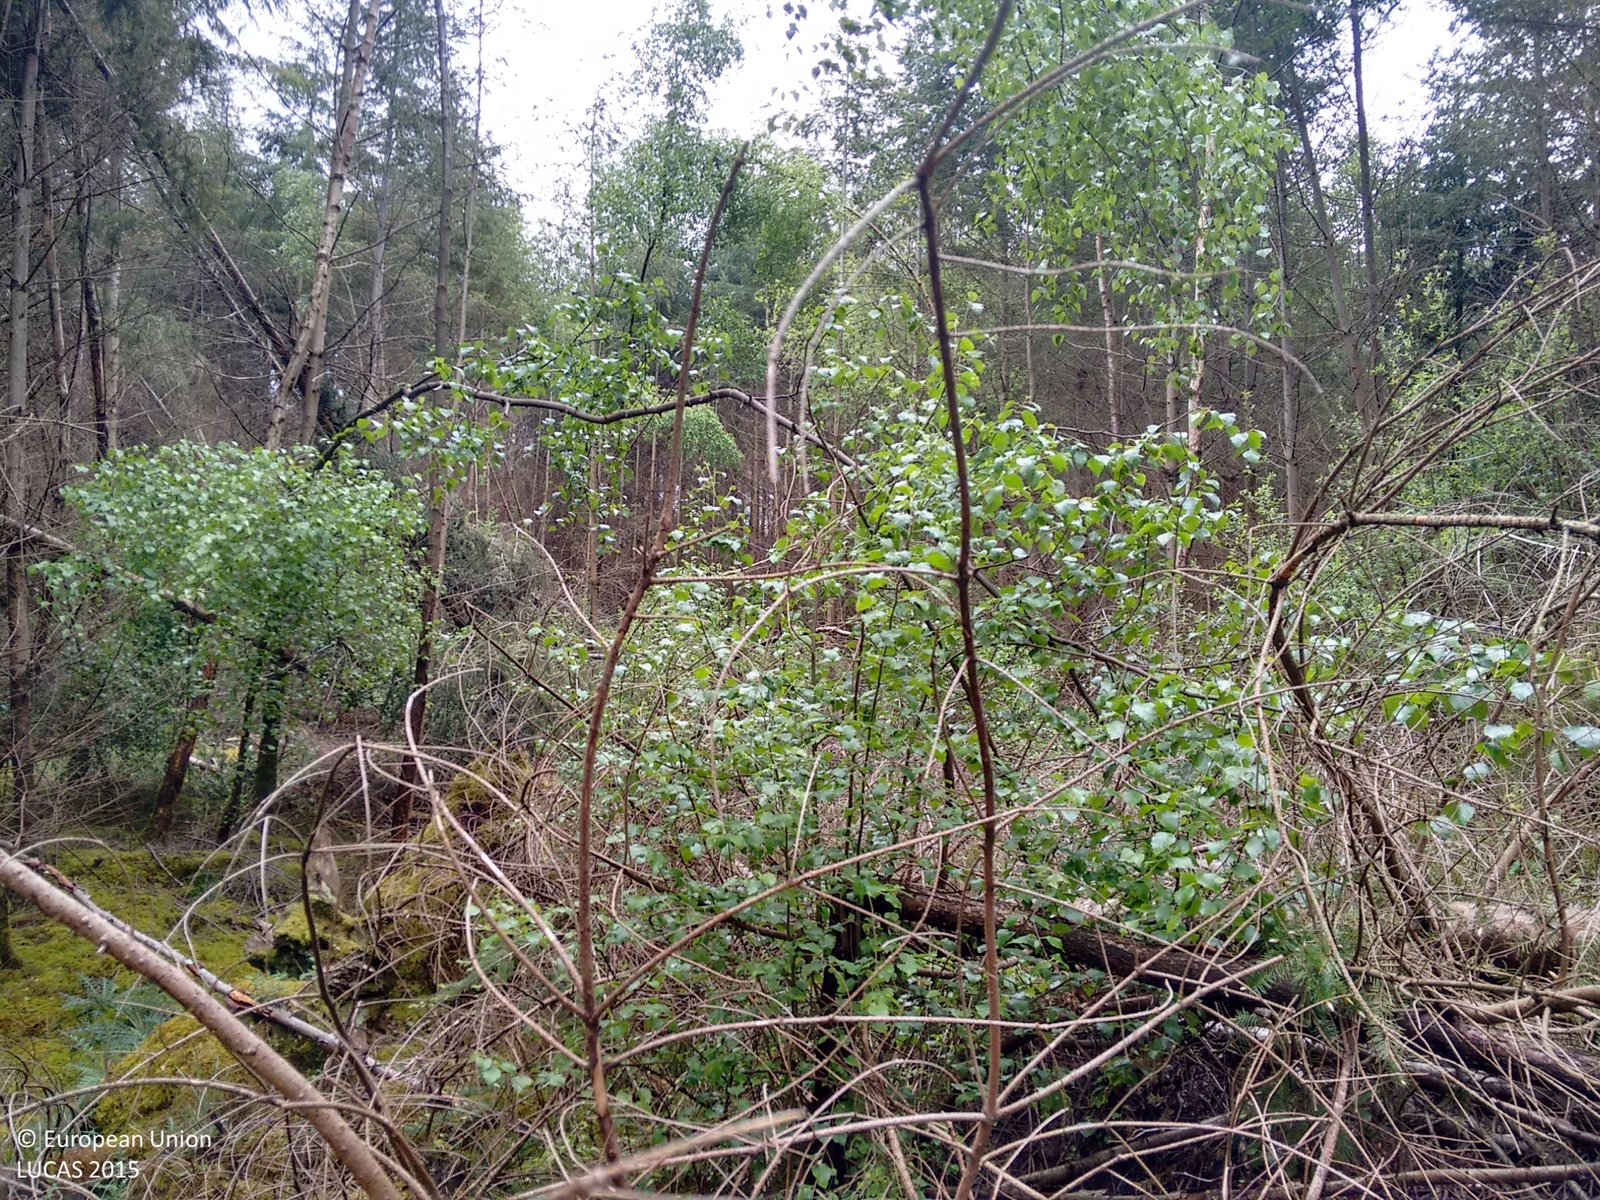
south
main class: Woodland
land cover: Spruce dominated coniferous woodland
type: exotic forest
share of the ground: > 75 %
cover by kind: coniferous forest trees 90 %, lichens and mosses 10 %
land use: Forestry
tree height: > 5 m
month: May
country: GB
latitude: 51.1895
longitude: -0.8452
